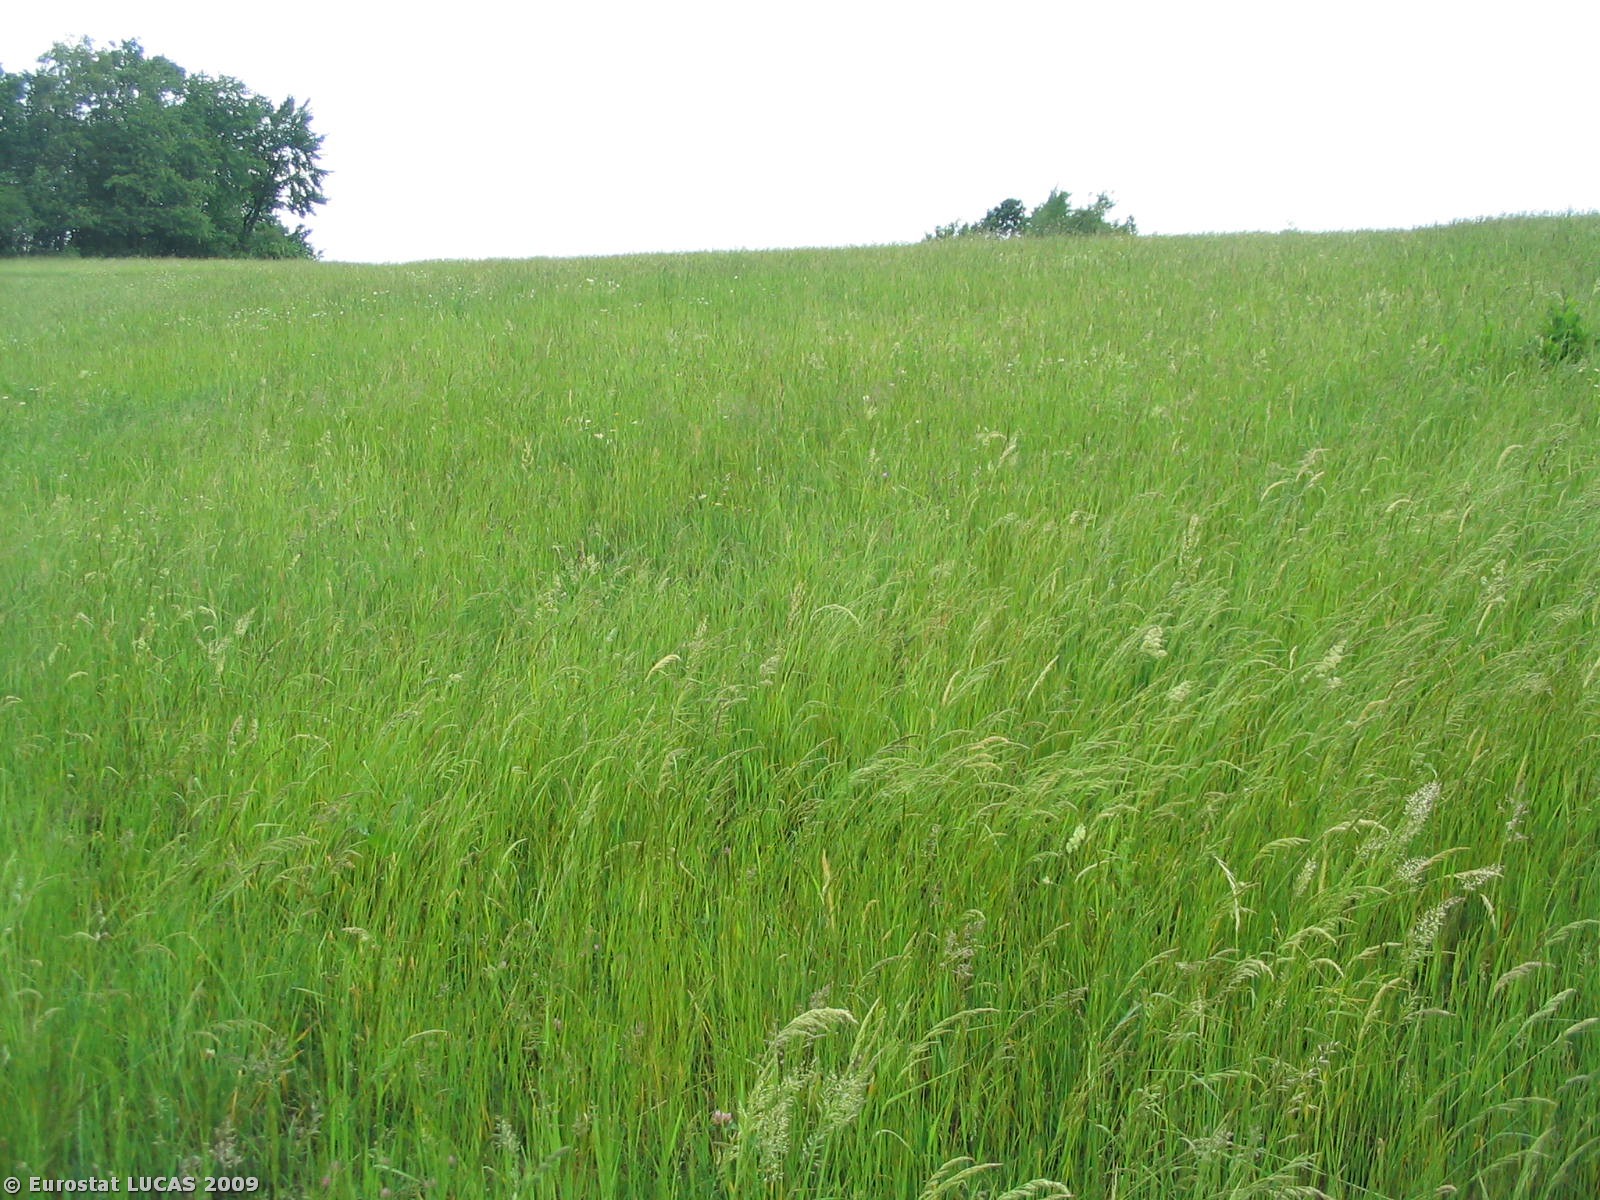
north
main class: Grassland
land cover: Grassland without tree/shrub cover
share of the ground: > 75 %
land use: Agriculture (excluding fallow land and kitchen gardens)
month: May
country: CZ
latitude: 49.4946
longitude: 16.4823
